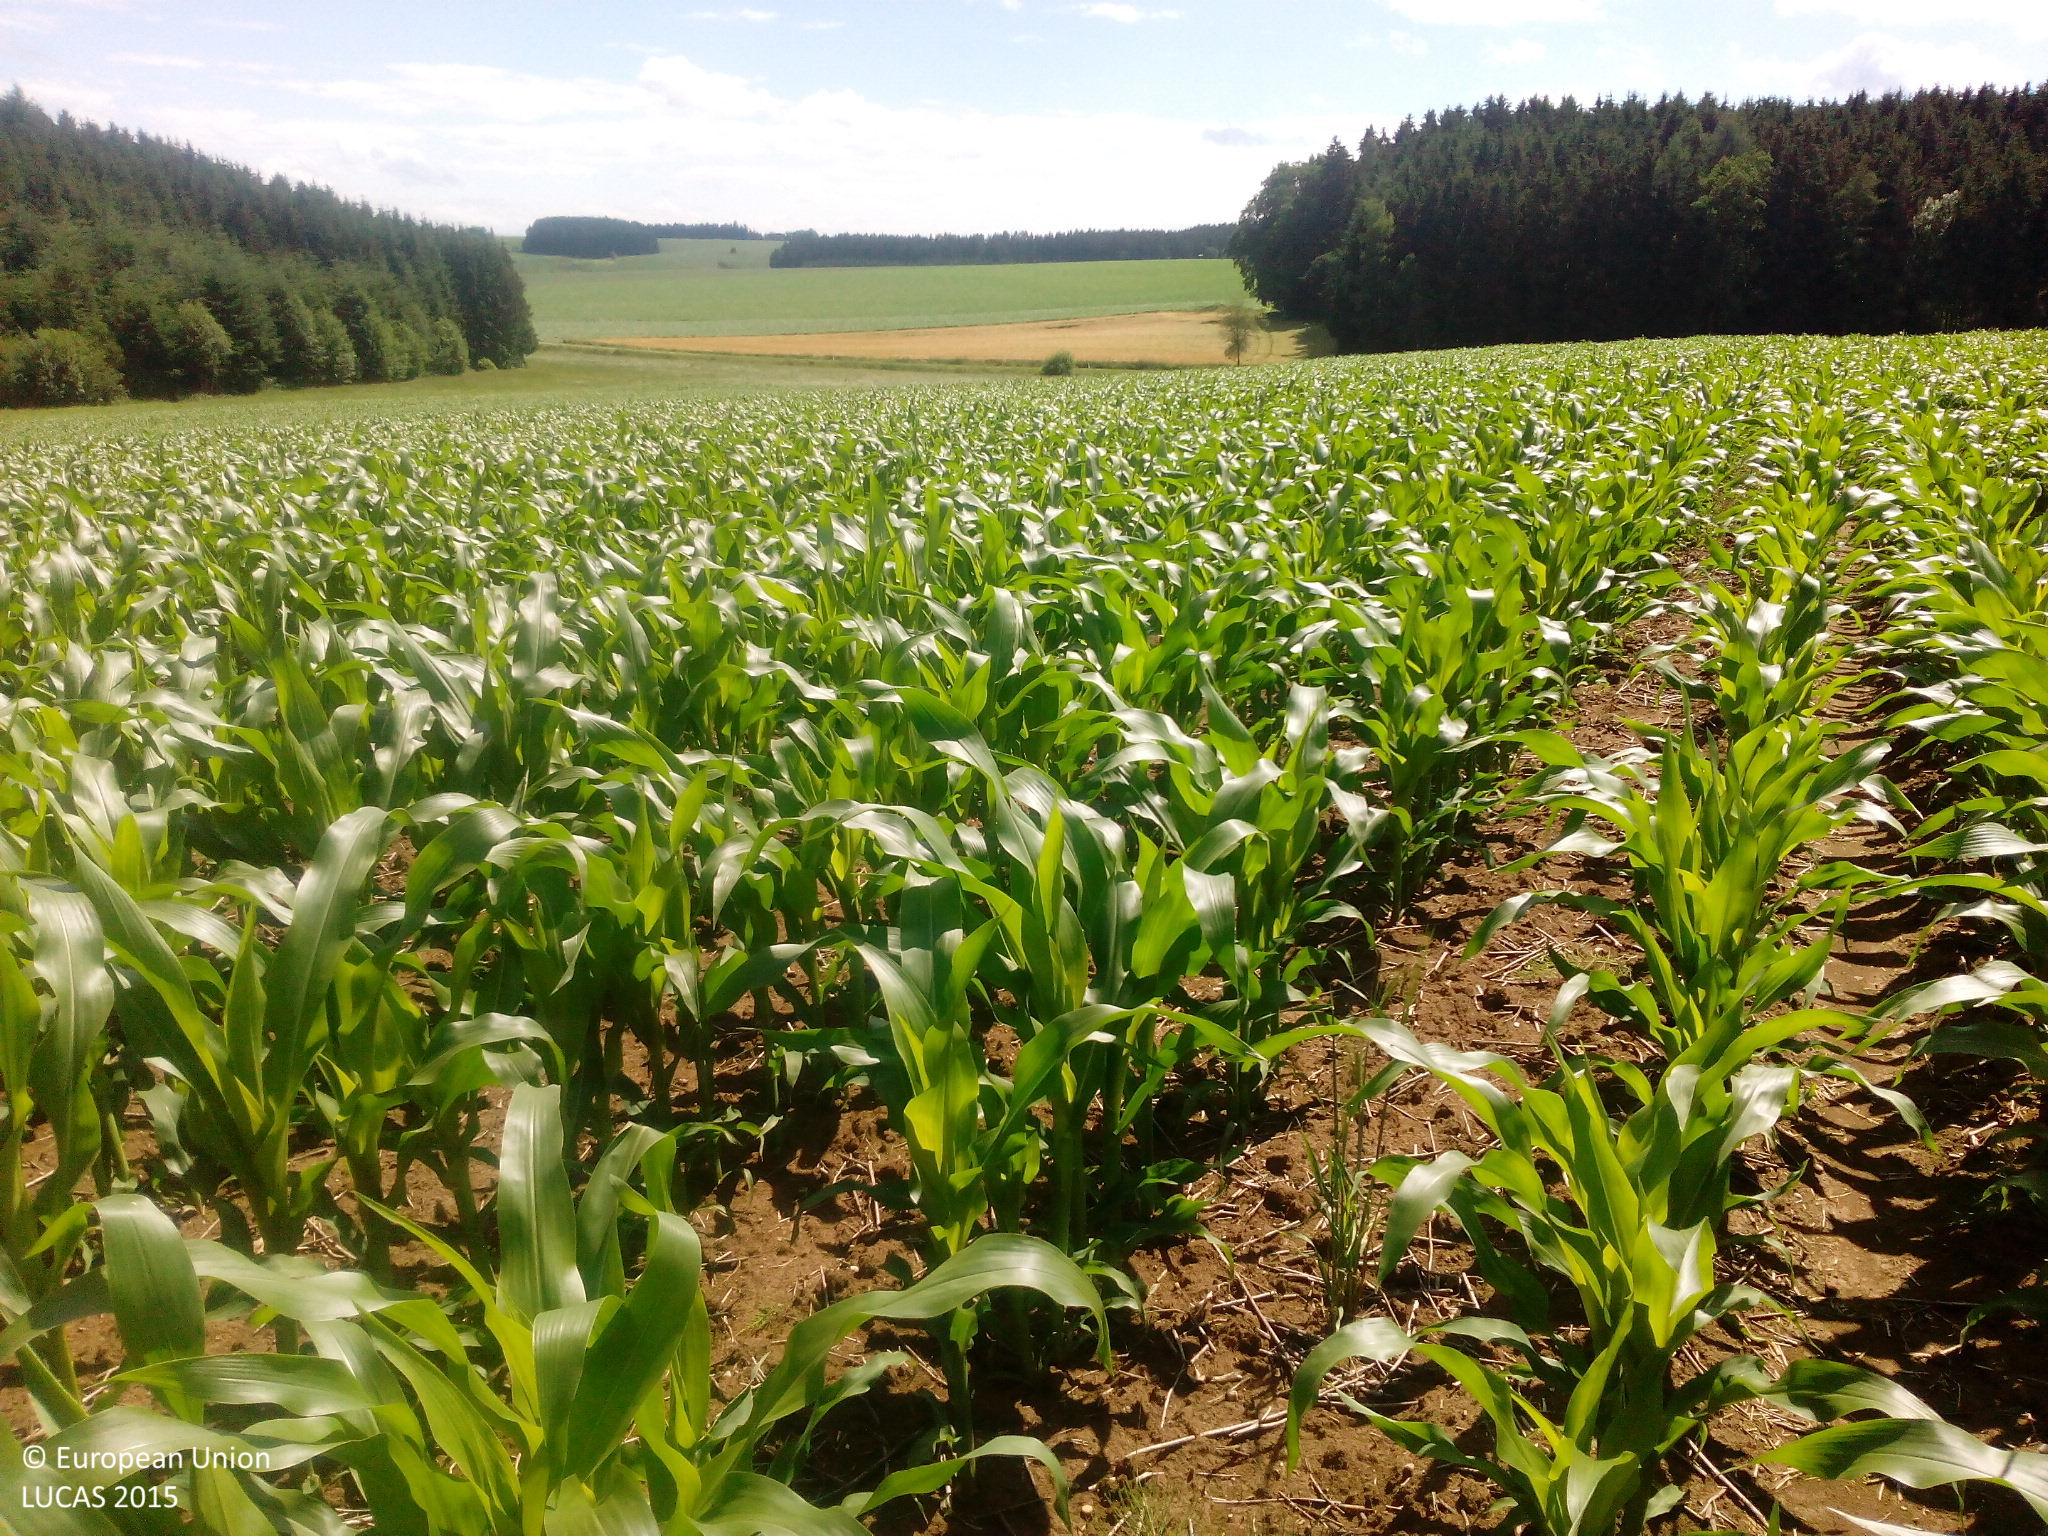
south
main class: Cropland
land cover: Maize
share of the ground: 25 - 50 %
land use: Agriculture (excluding fallow land and kitchen gardens)
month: June
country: DE
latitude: 48.6029
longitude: 11.9114
